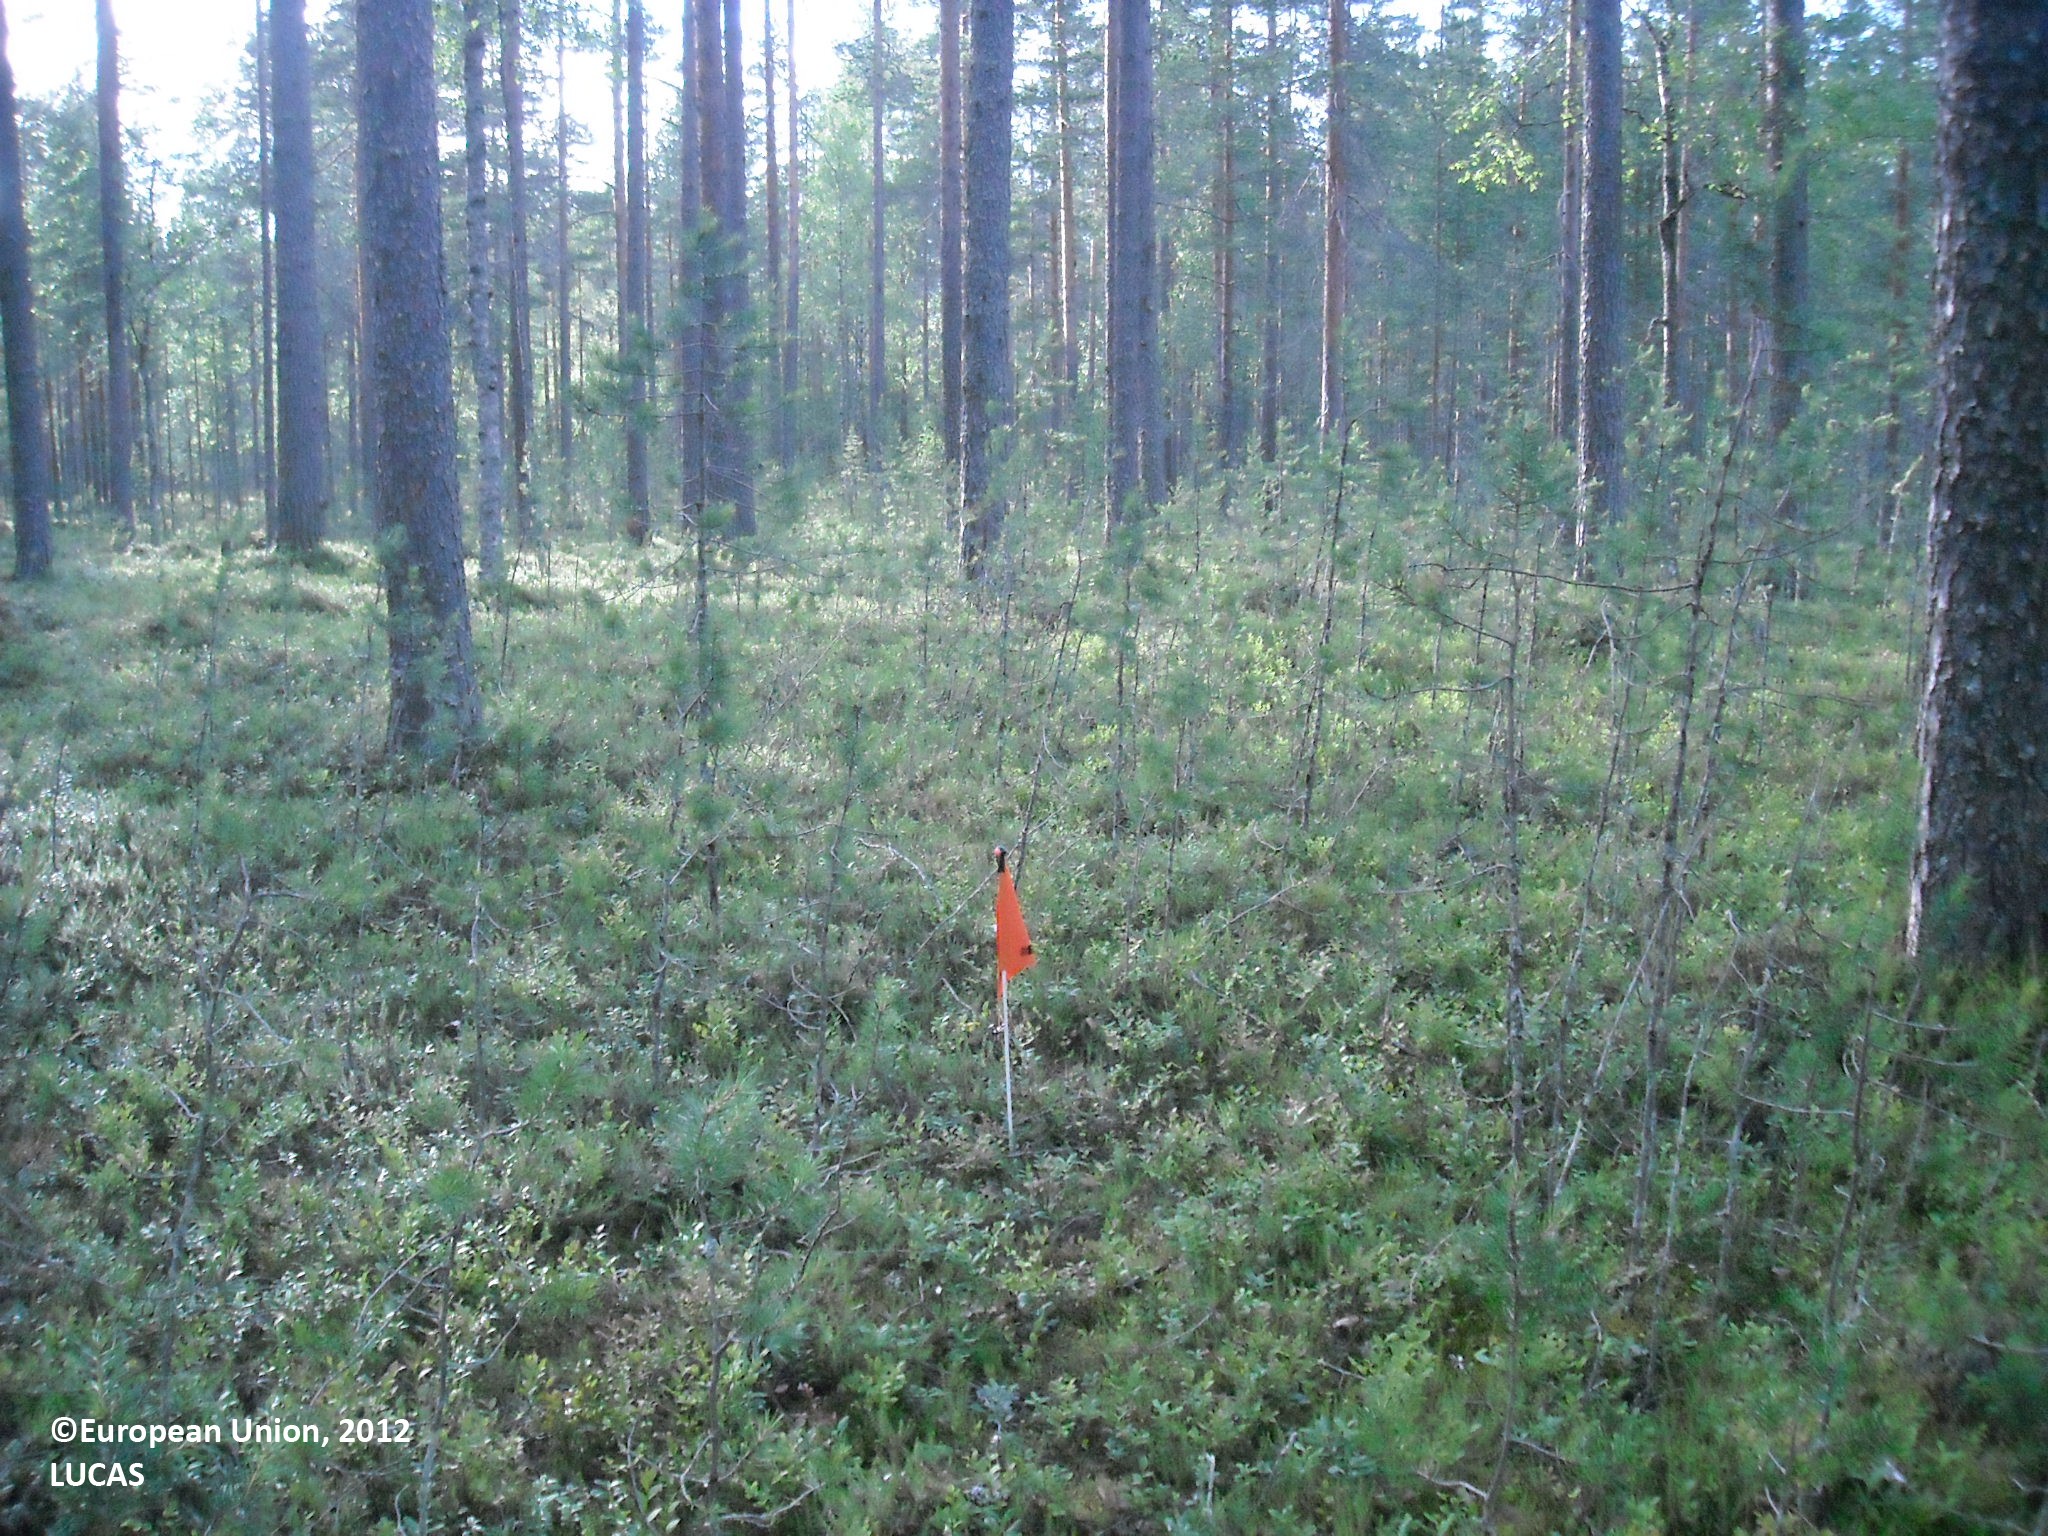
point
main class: Woodland
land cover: Pine dominated mixed woodland
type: boreal forest
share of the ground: 50 - 75 %
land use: Forestry
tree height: > 5 m
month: July
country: FI
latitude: 65.0834
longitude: 26.8585
